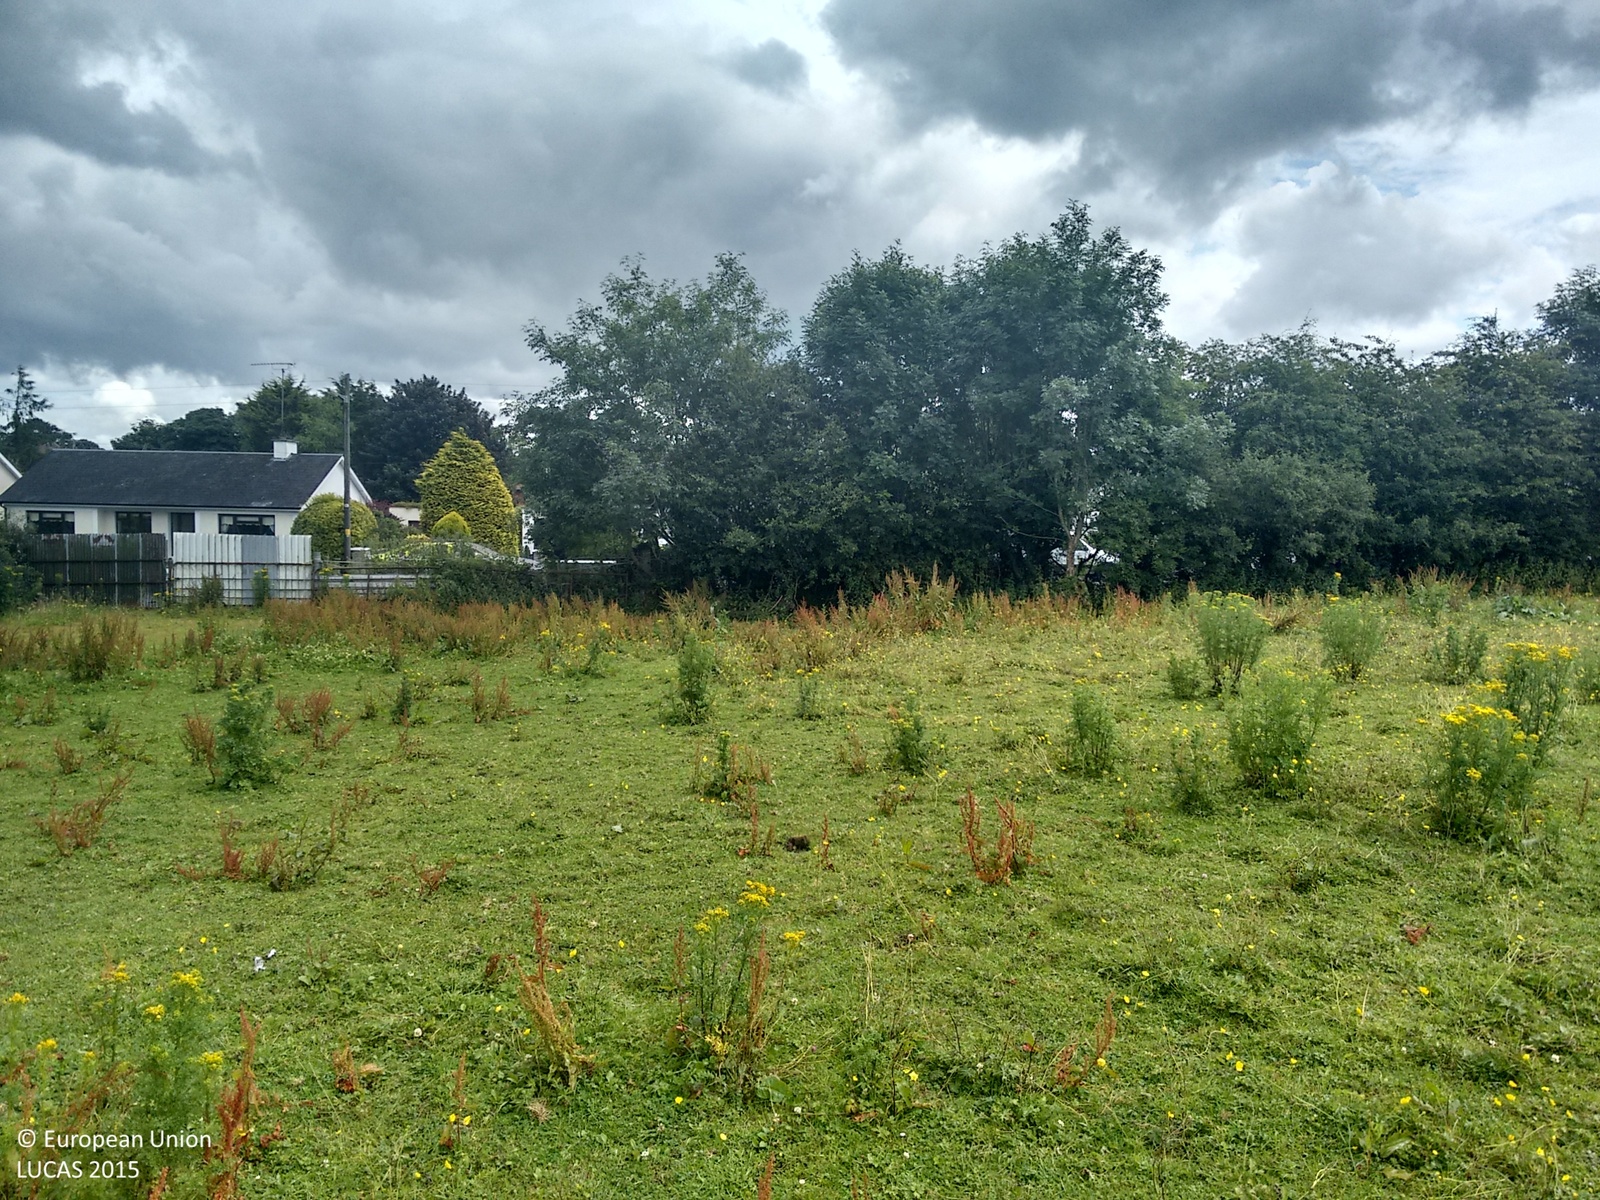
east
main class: Grassland
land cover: Grassland without tree/shrub cover
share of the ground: > 75 %
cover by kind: herbaceous plants 100 %
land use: Agriculture (excluding fallow land and kitchen gardens)
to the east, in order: Grassland without tree/shrub cover; Fences; Managed hedges; Artificial constructions in urban areas; Grassland without tree/shrub cover; Electric lines; Grassland without tree/shrub cover; Broadleaved woodland; Fences; Shrubland with sparse tree cover; Artificial constructions in urban areas
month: July
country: IE
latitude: 53.7454
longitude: -7.8026
